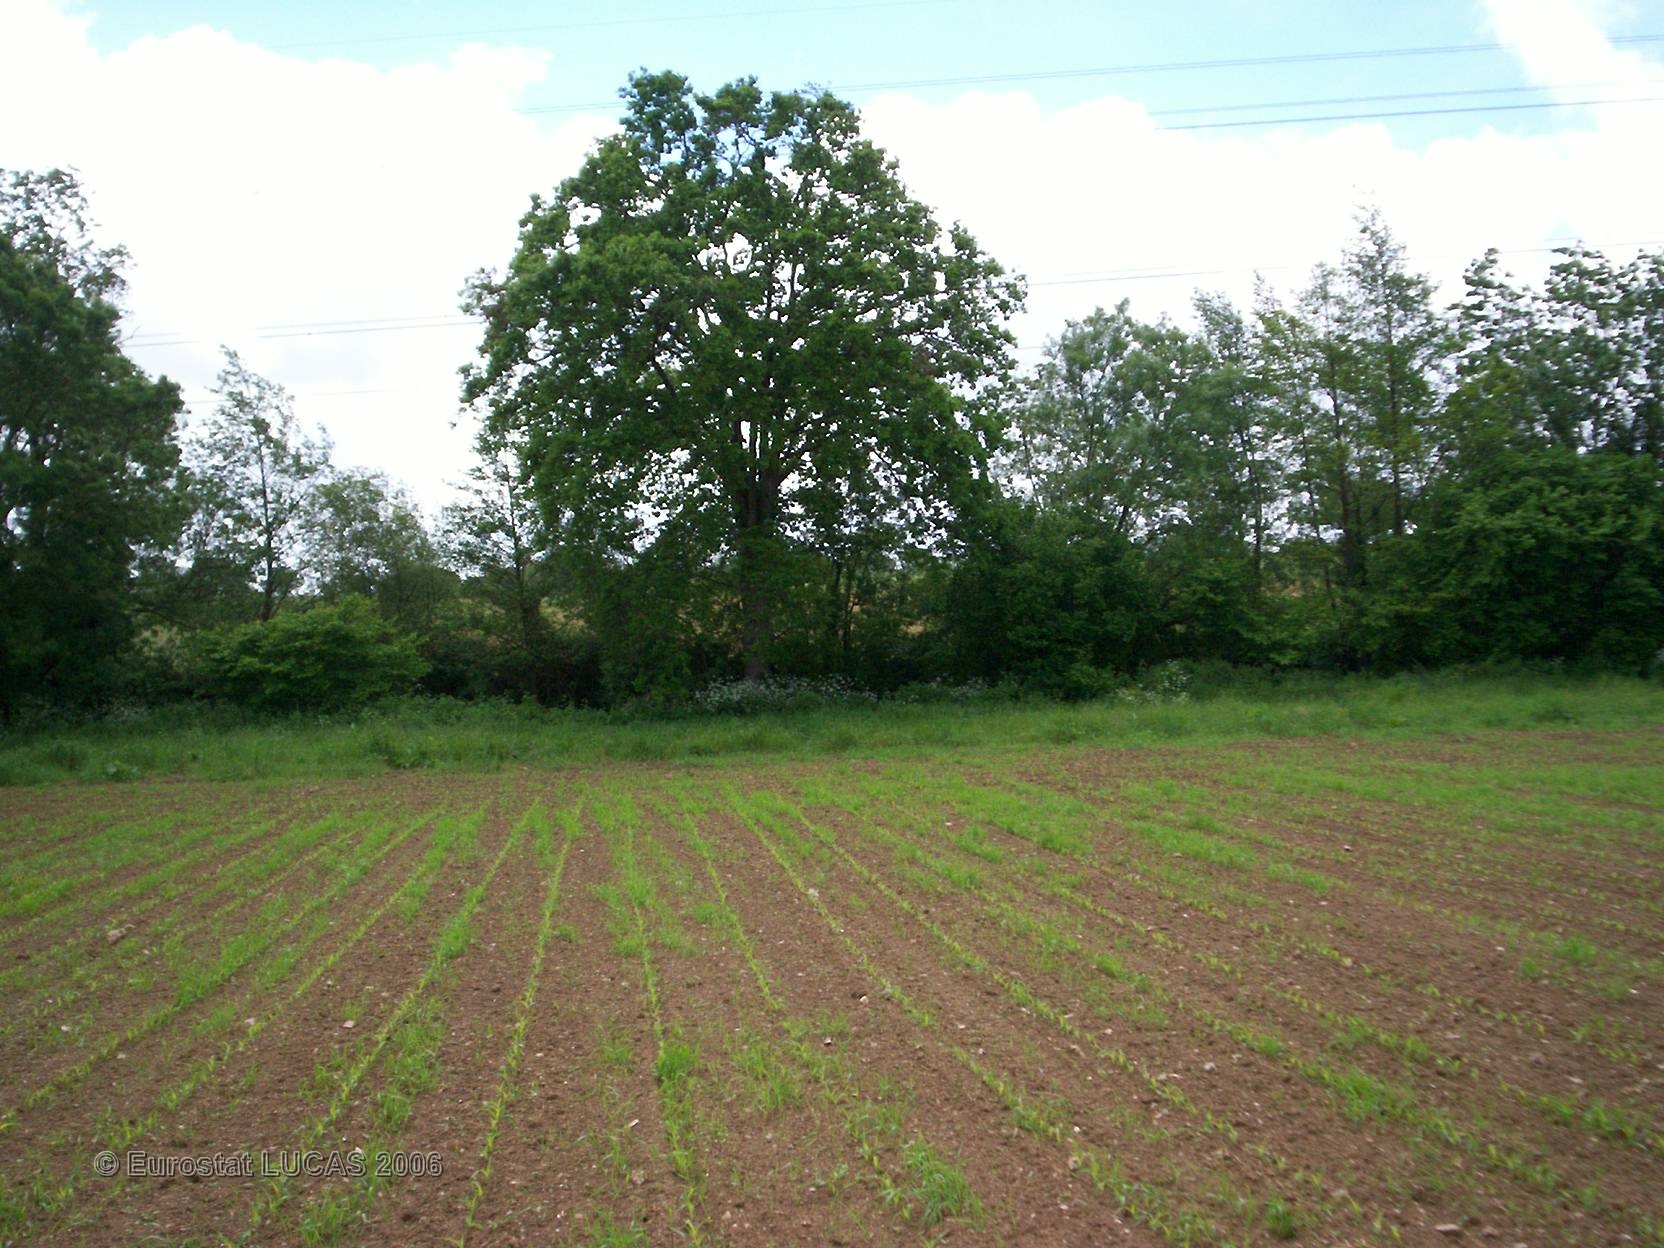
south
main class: Cropland
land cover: Maize
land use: Agriculture (excluding fallow land and kitchen gardens)
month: May
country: FR
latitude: 47.4243
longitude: -1.4555
